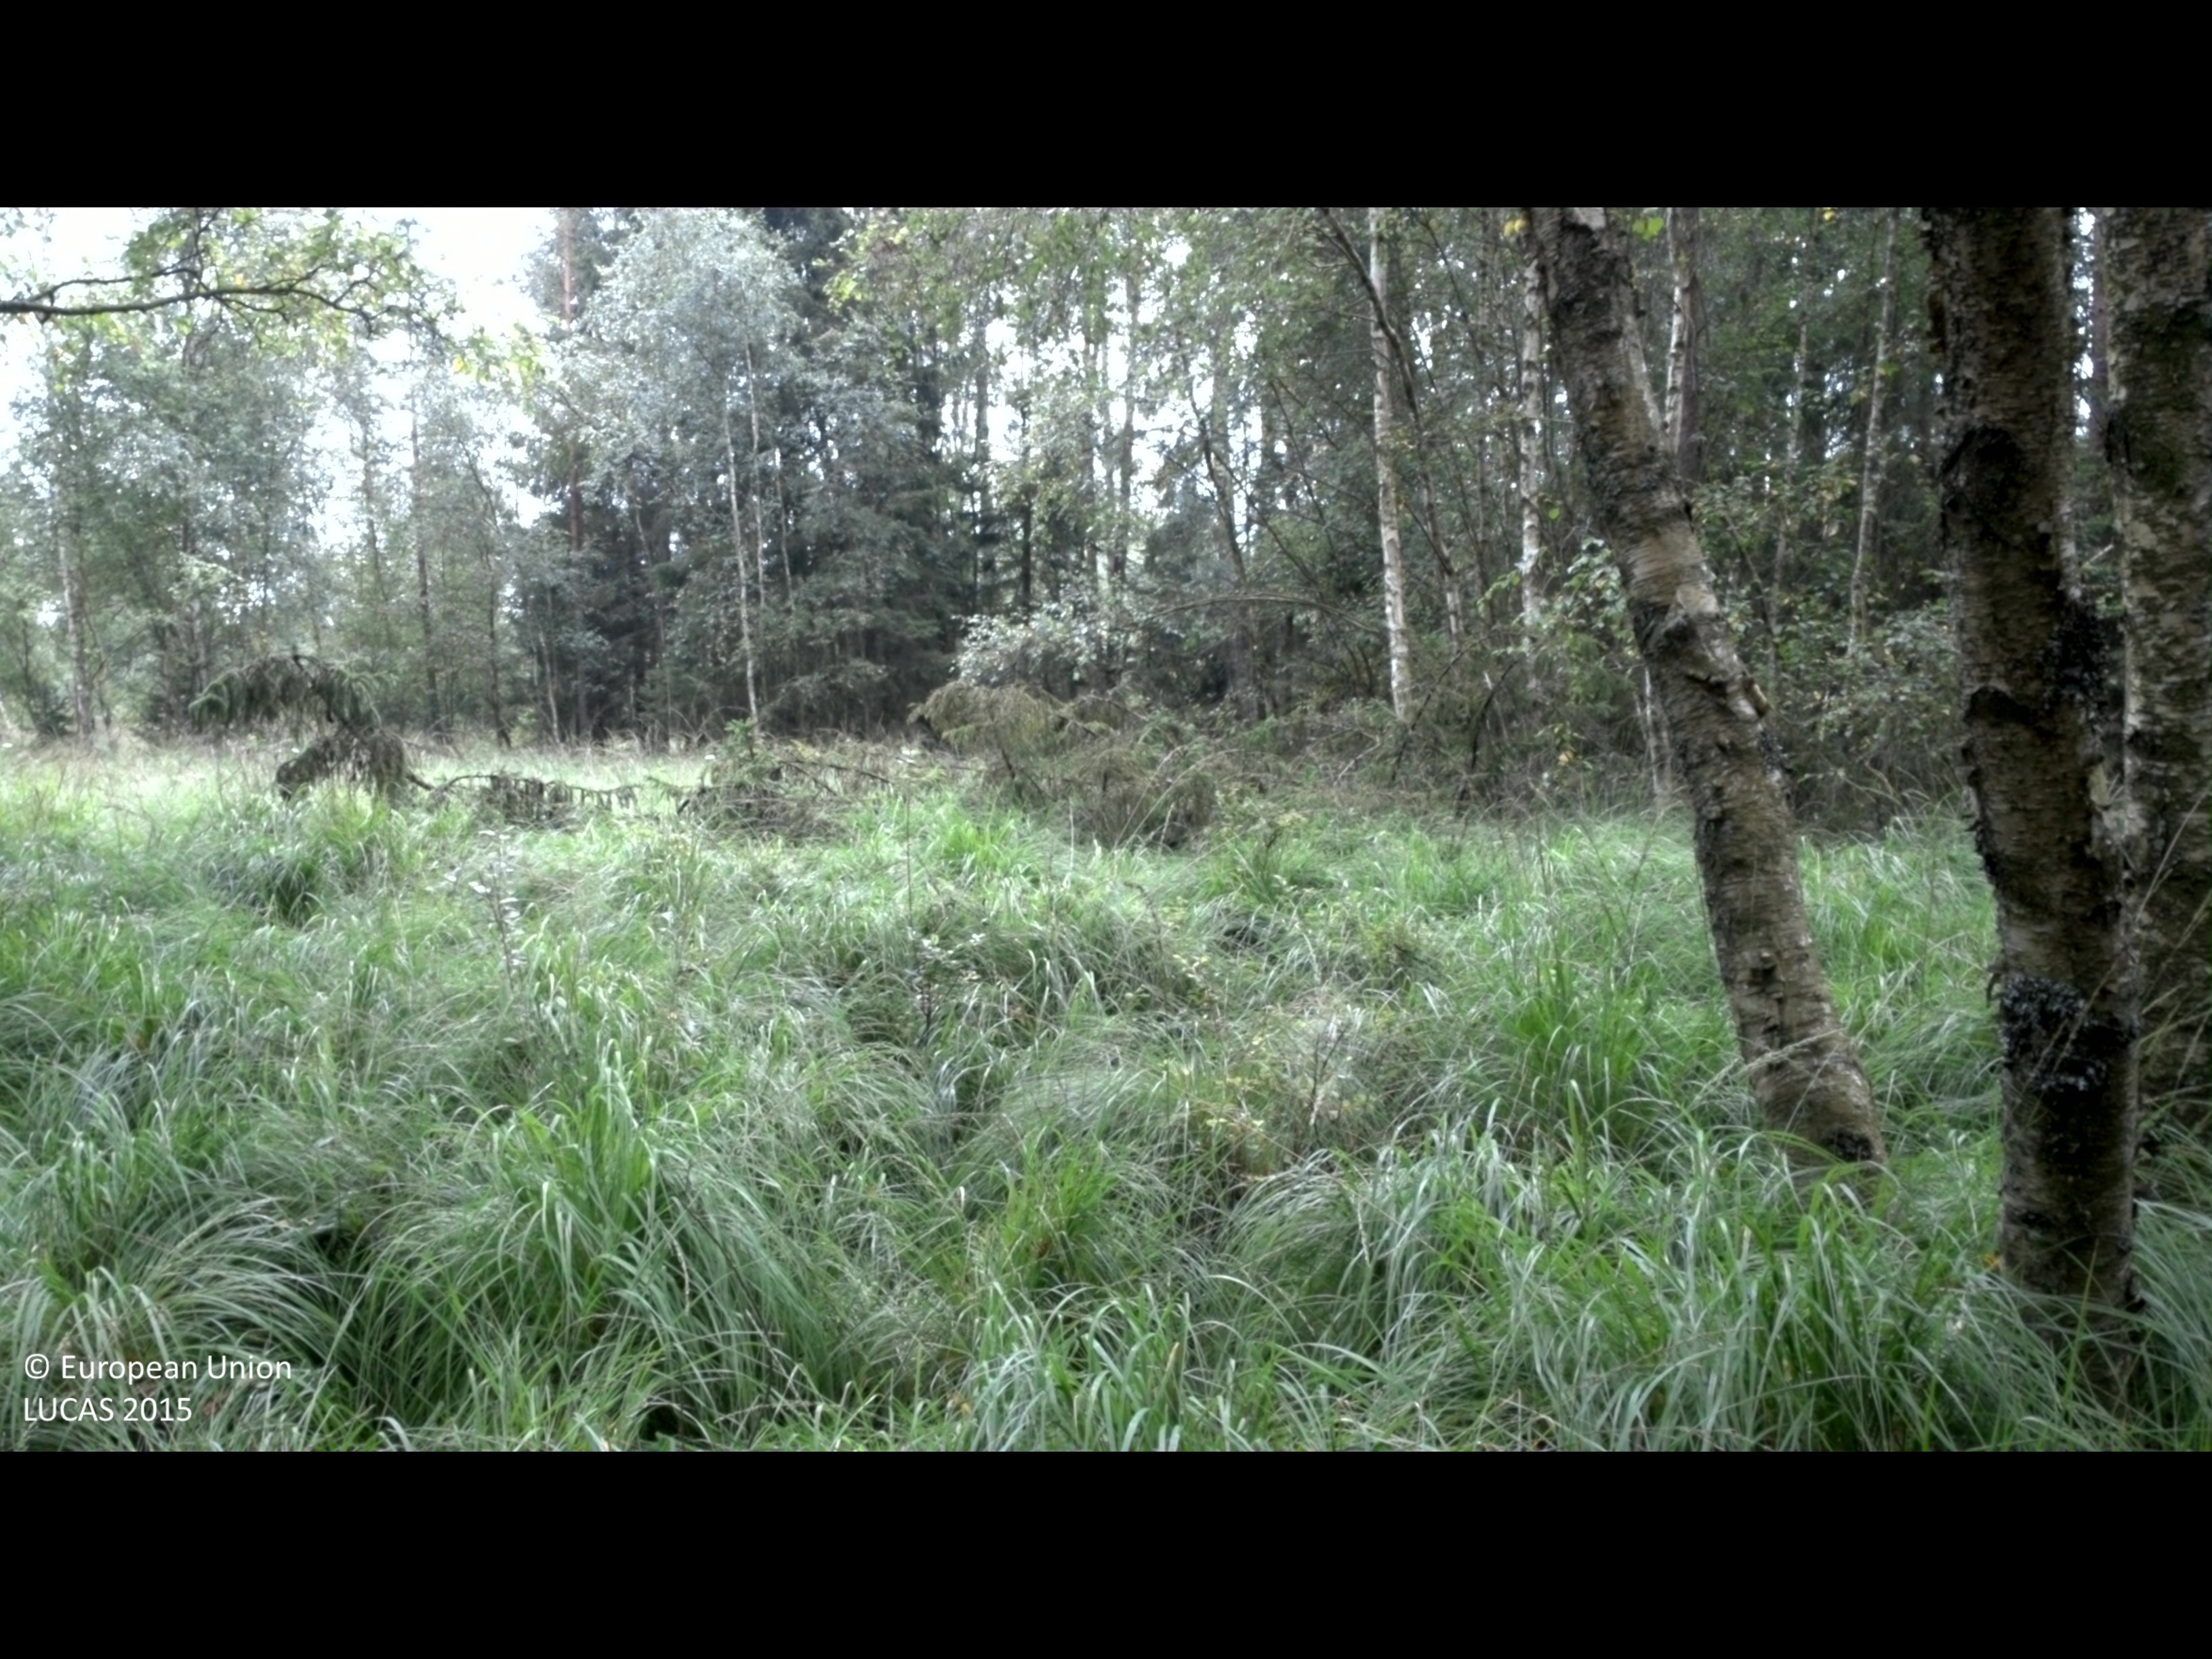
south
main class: Woodland
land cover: Broadleaved woodland
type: boreal forest
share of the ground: 25 - 50 %
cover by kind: herbaceous plants 55 %, broadleaved forest trees 40 %, shrubs 5 %
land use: Semi-natural and natural areas not in use
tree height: > 5 m
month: August
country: SE
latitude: 56.9232
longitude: 13.1344
